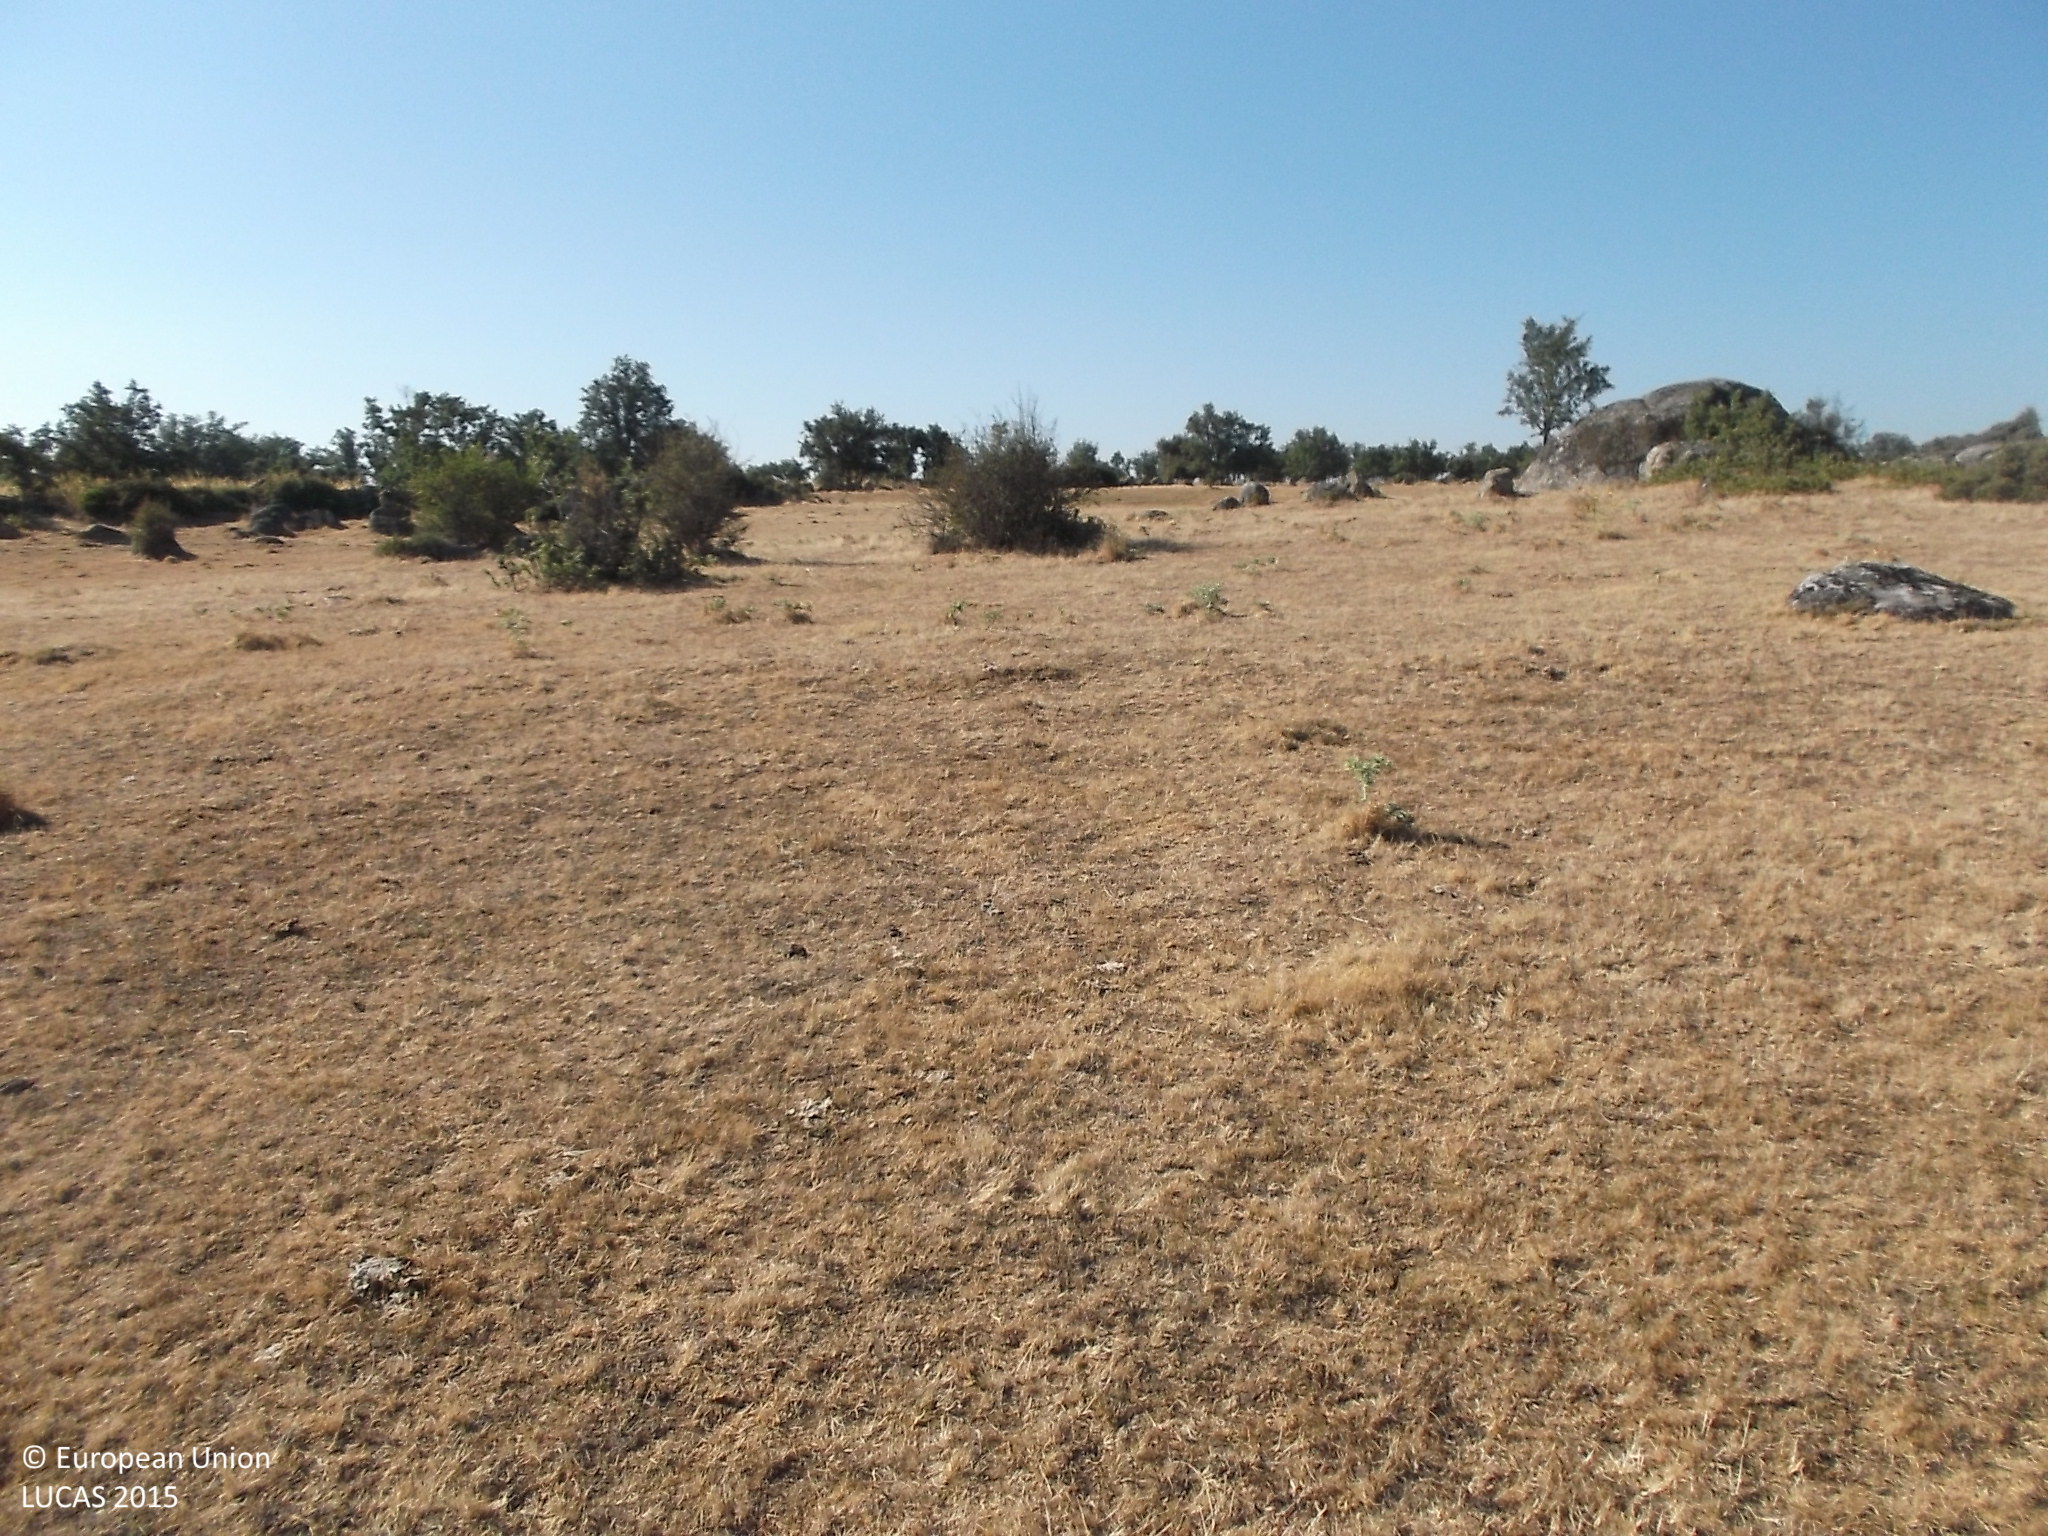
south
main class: Grassland
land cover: Grassland without tree/shrub cover
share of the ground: > 75 %
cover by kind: herbaceous plants 100 %
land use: Agriculture (excluding fallow land and kitchen gardens)
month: July
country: ES
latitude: 41.3329
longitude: -6.0175
